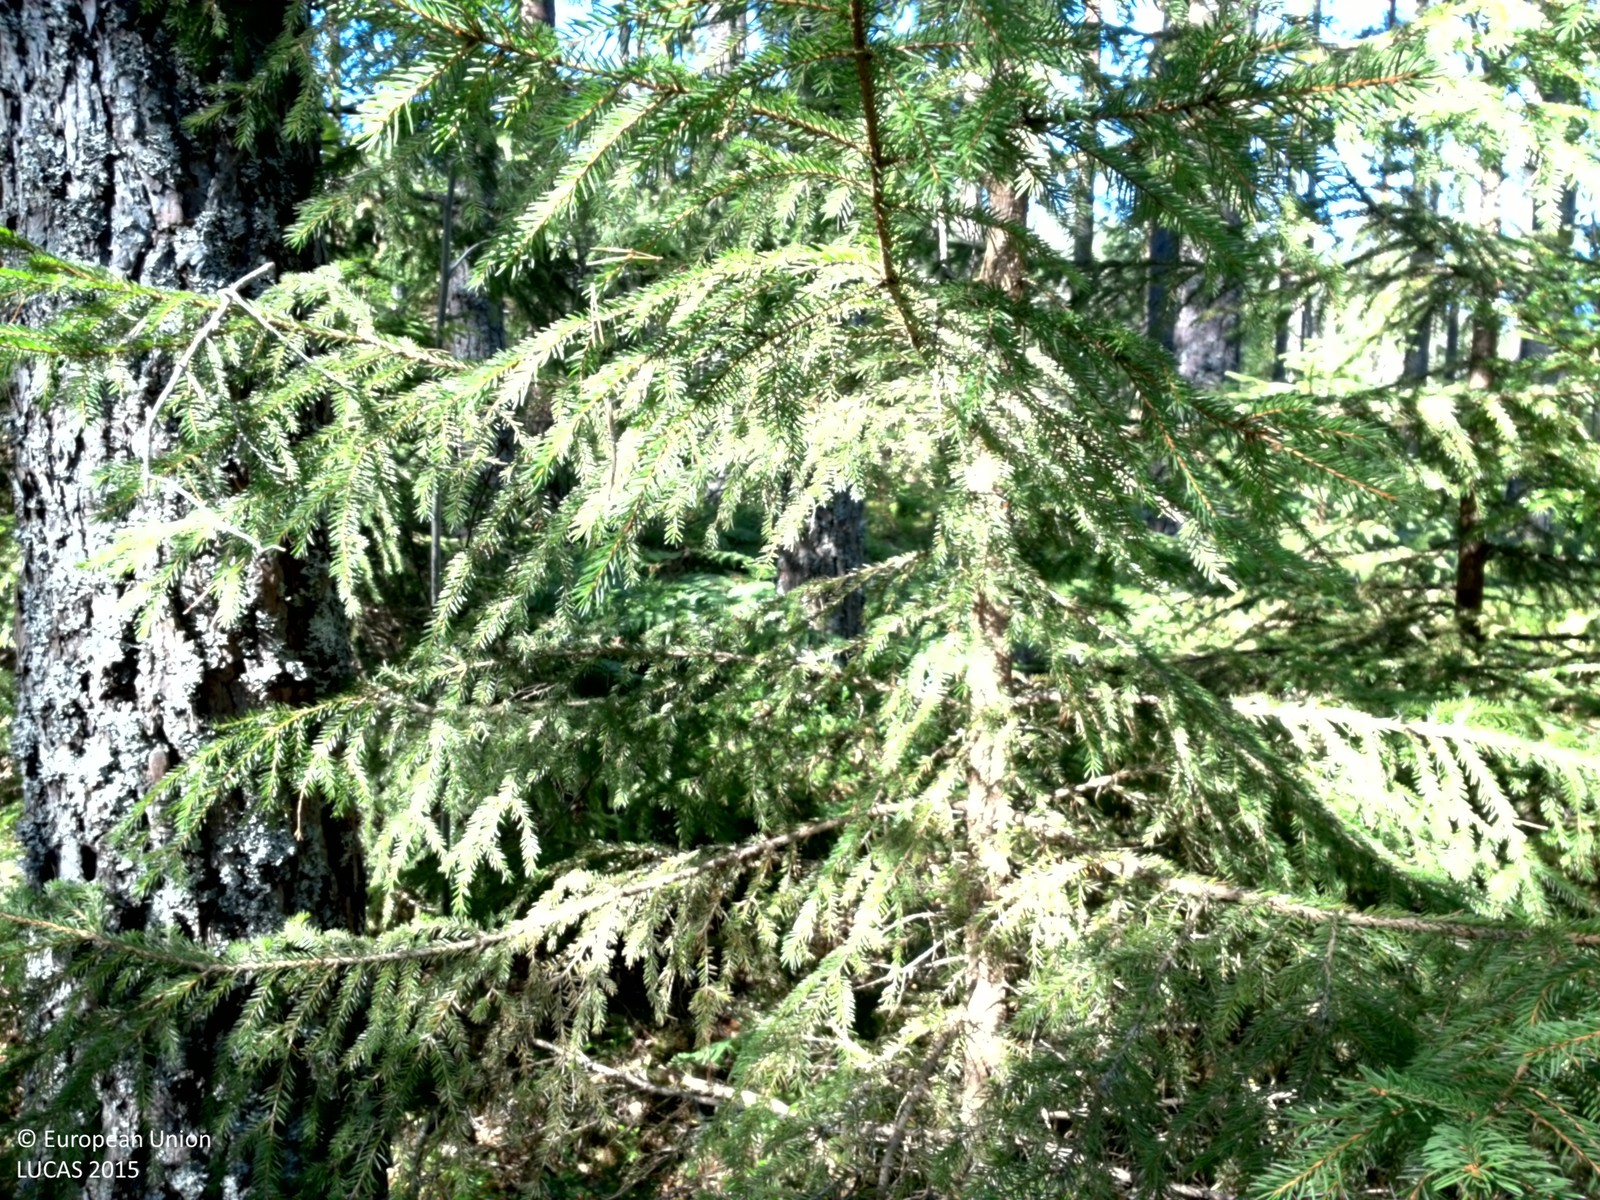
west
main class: Woodland
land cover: Other coniferous woodland
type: boreal forest
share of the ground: > 75 %
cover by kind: coniferous forest trees 75 %, shrubs 15 %, broadleaved forest trees 5 %, herbaceous plants 5 %
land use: Forestry
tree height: > 5 m
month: August
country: SE
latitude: 60.0782
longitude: 17.0187
